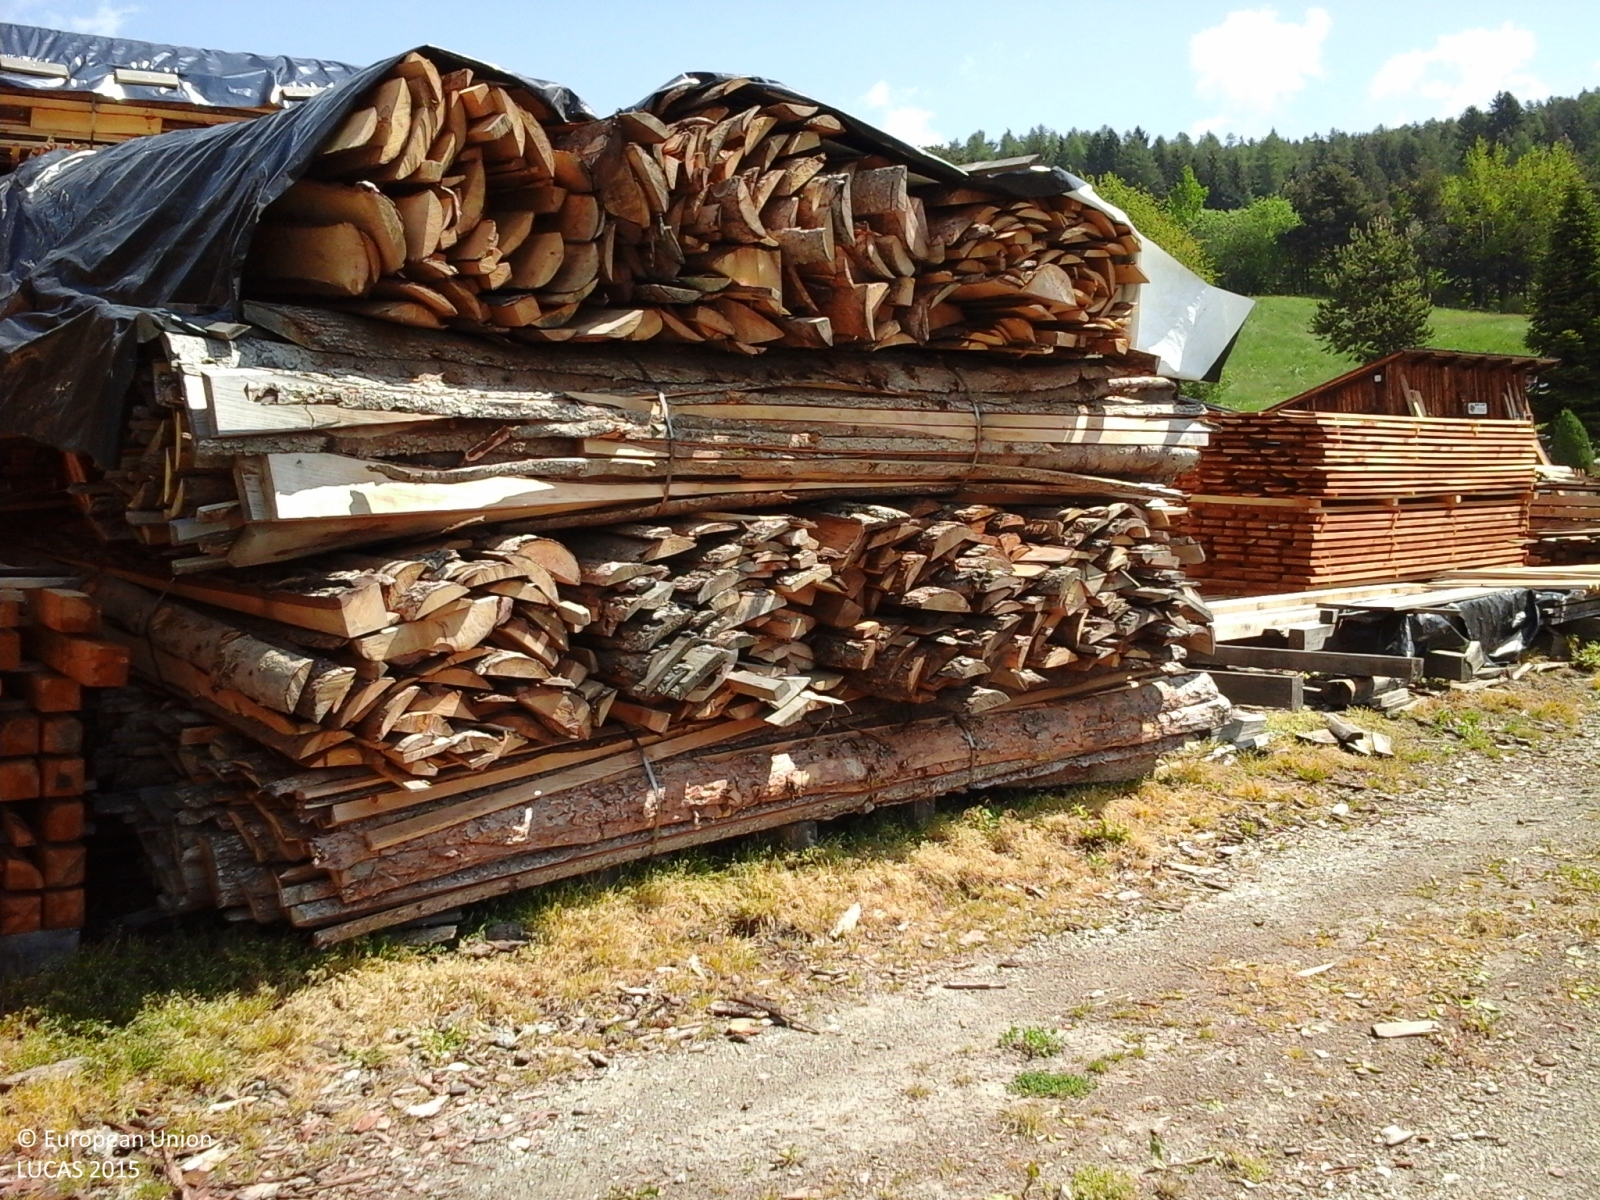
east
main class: Grassland
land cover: Grassland without tree/shrub cover
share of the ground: > 75 %
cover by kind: herbaceous plants 100 %
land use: Agriculture (excluding fallow land and kitchen gardens)
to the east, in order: Grassland without tree/shrub cover; Artificial constructions in urban areas; Grassland without tree/shrub cover; Spruce dominated mixed woodland
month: May
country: IT
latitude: 46.6098
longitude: 11.5780
